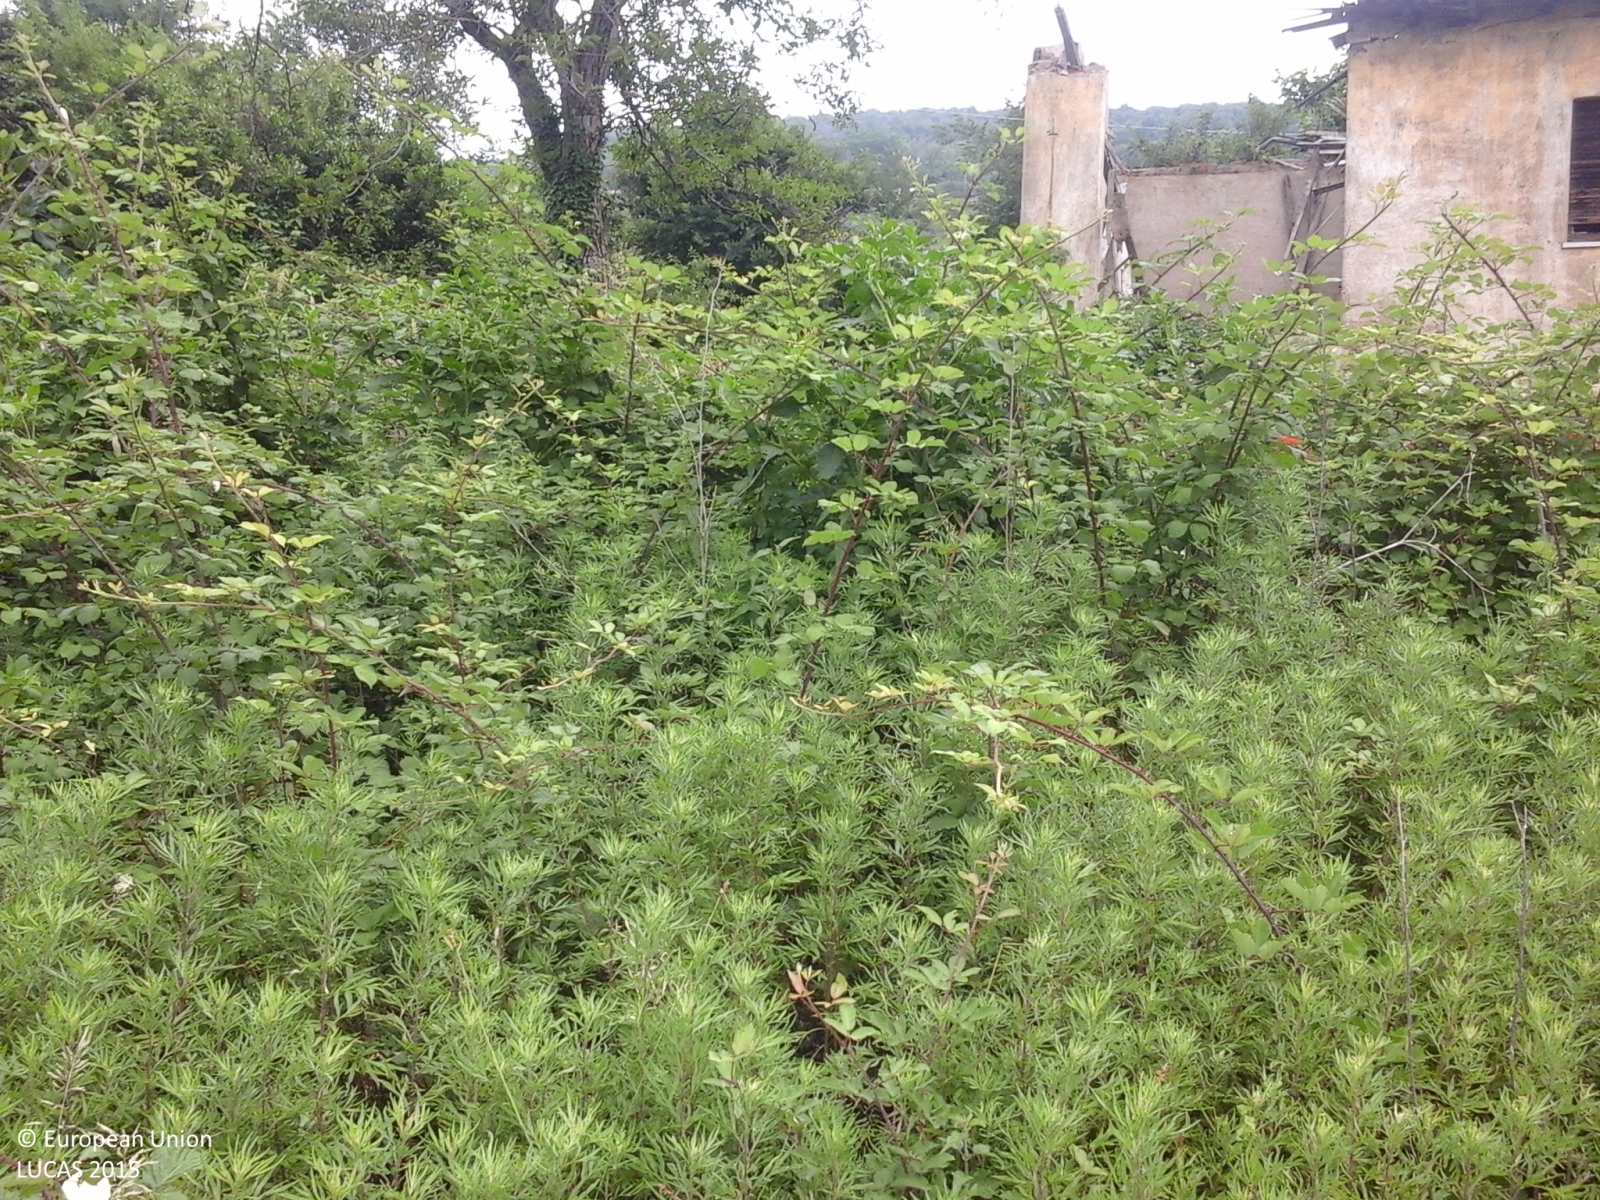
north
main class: Grassland
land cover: Spontaneously vegetated surfaces
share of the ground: > 75 %
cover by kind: herbaceous plants 100 %
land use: Abandoned areas
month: June
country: IT
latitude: 45.6485
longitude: 9.8847
